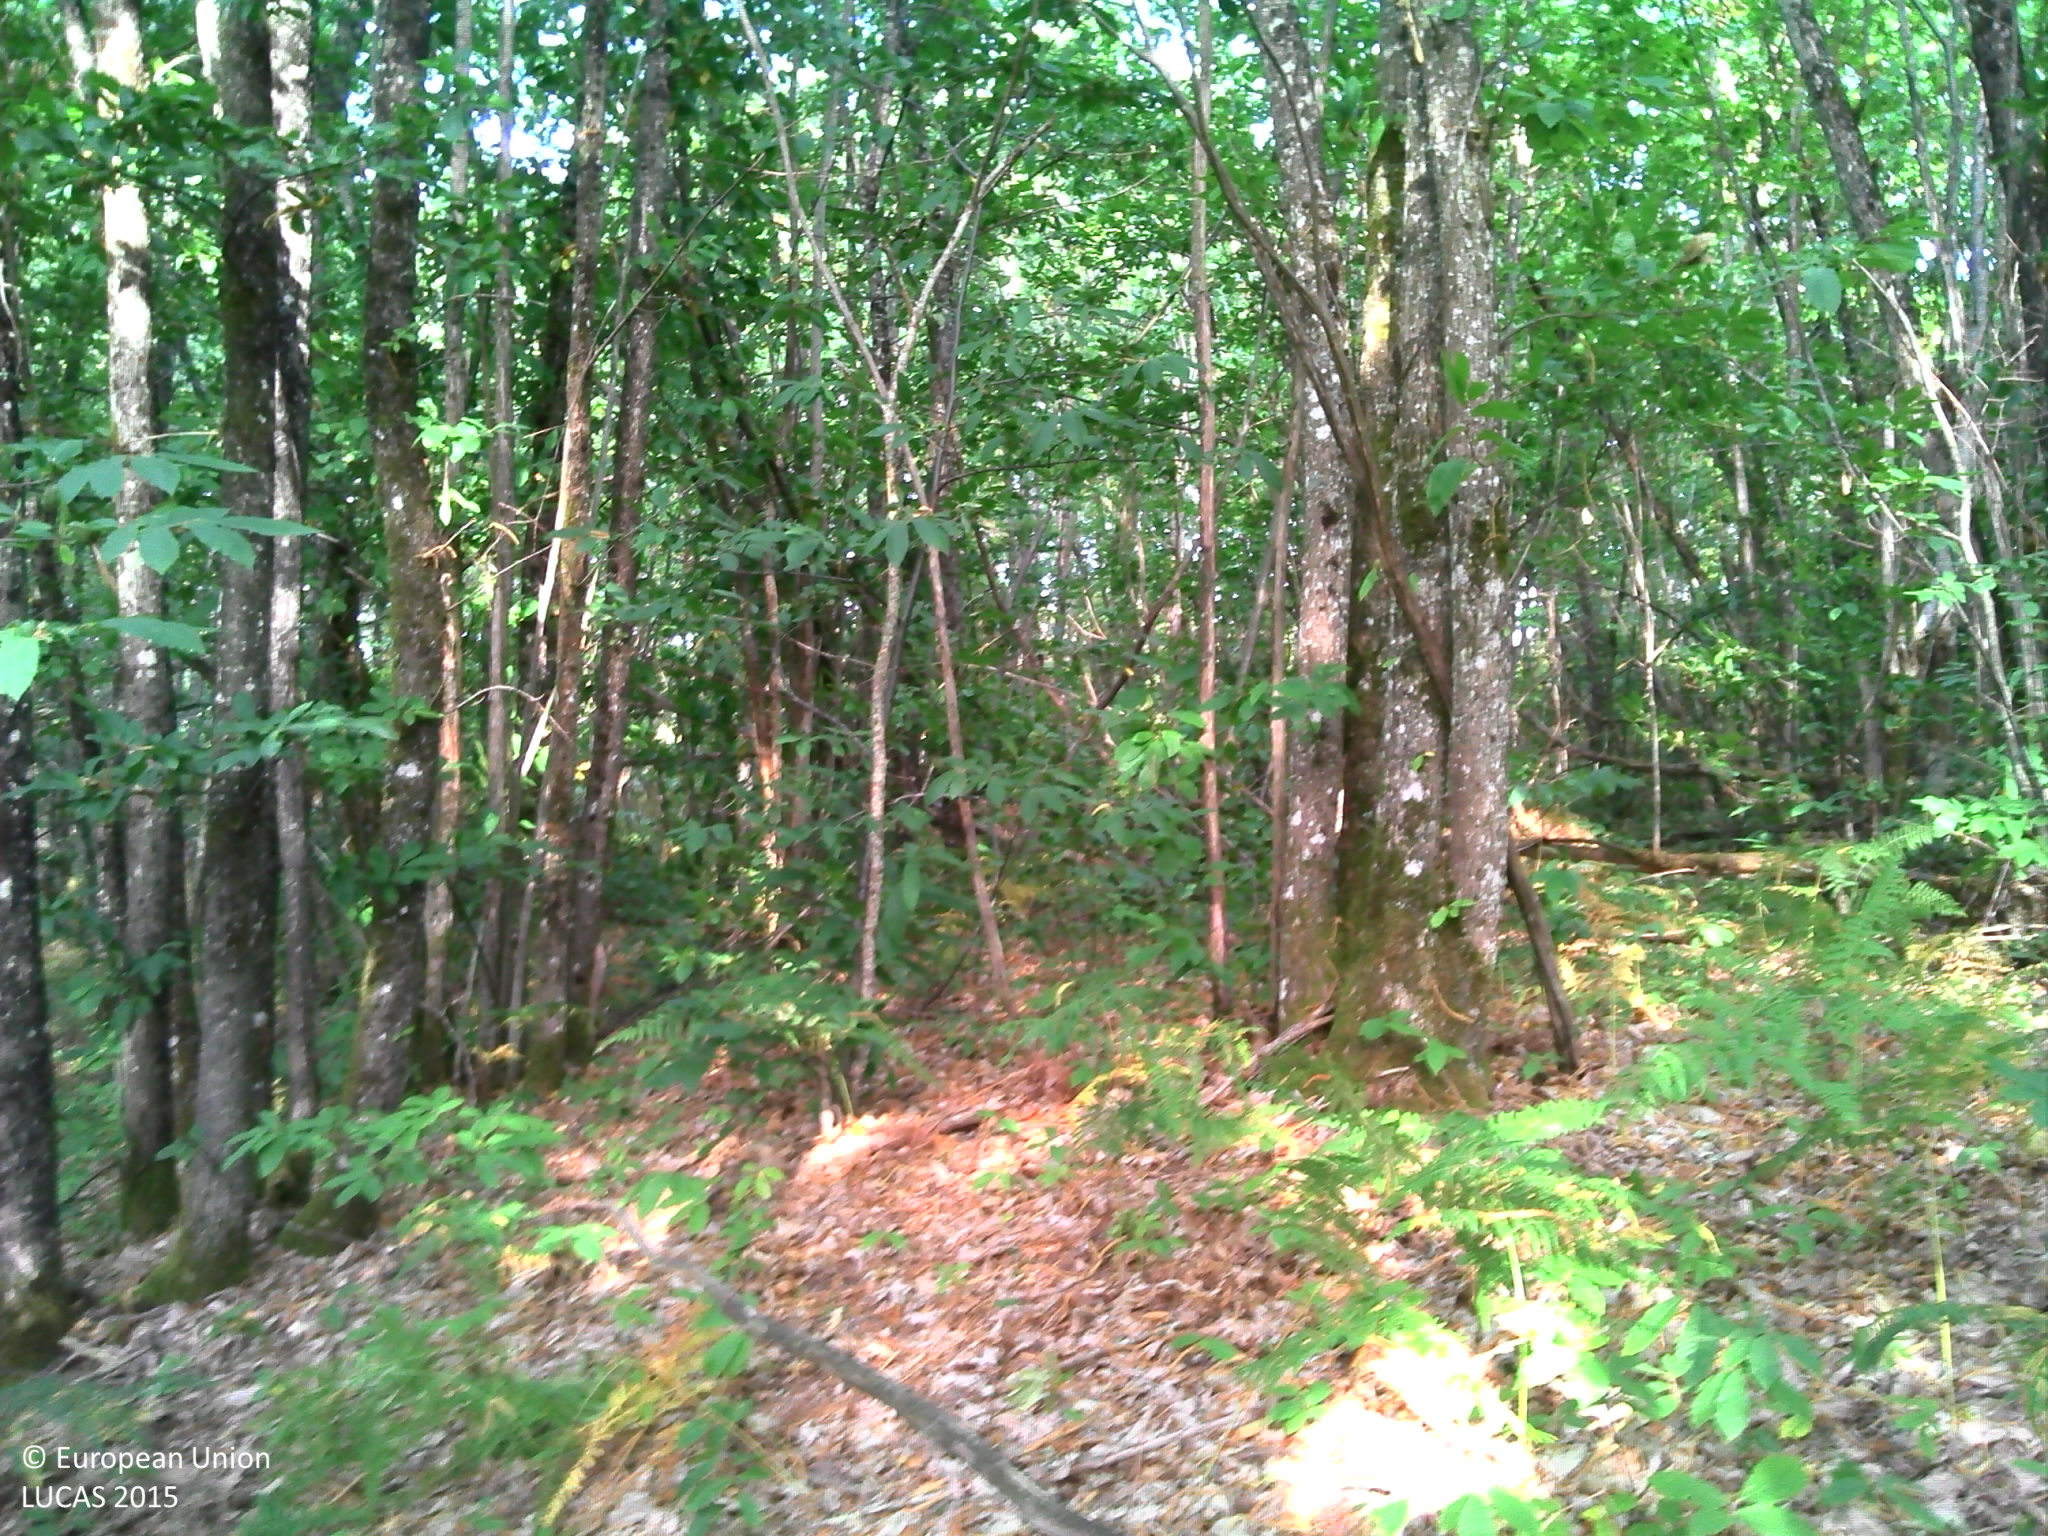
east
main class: Woodland
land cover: Broadleaved woodland
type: thermophilous deciduous forest
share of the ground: > 75 %
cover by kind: broadleaved forest trees 80 %, shrubs 10 %, herbaceous plants 5 %, lichens and mosses 5 %
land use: Forestry
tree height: > 5 m
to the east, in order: Broadleaved woodland; Grass margins; Tracks; Grassland without tree/shrub cover; Tracks; Broadleaved woodland
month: July
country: FR
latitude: 45.0262
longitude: 0.5599
